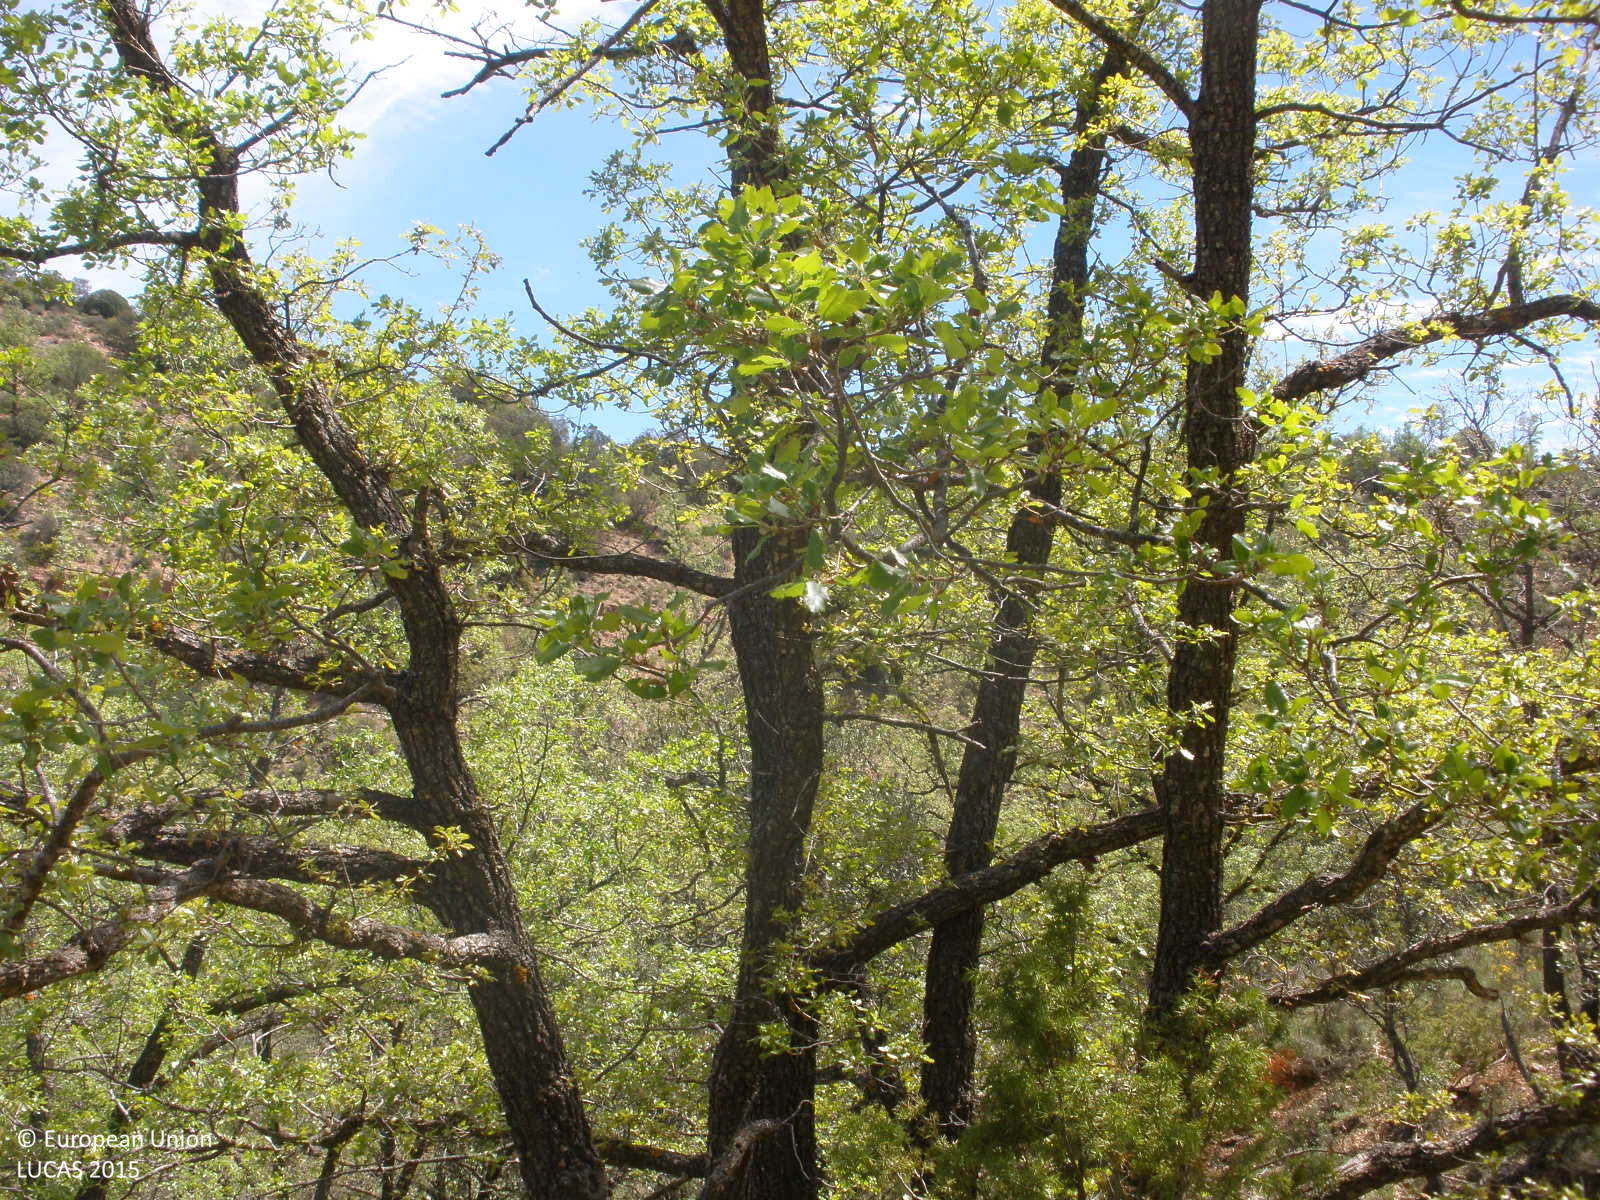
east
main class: Woodland
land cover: Broadleaved woodland
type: broadleaved evergreen forest
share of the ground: > 75 %
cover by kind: broadleaved forest trees 70 %, shrubs 20 %, consolidated bare surface 10 %
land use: Semi-natural and natural areas not in use
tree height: > 5 m
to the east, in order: Broadleaved woodland; Rivers and streams; Broadleaved woodland
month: May
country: ES
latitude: 40.8777
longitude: -0.9201
